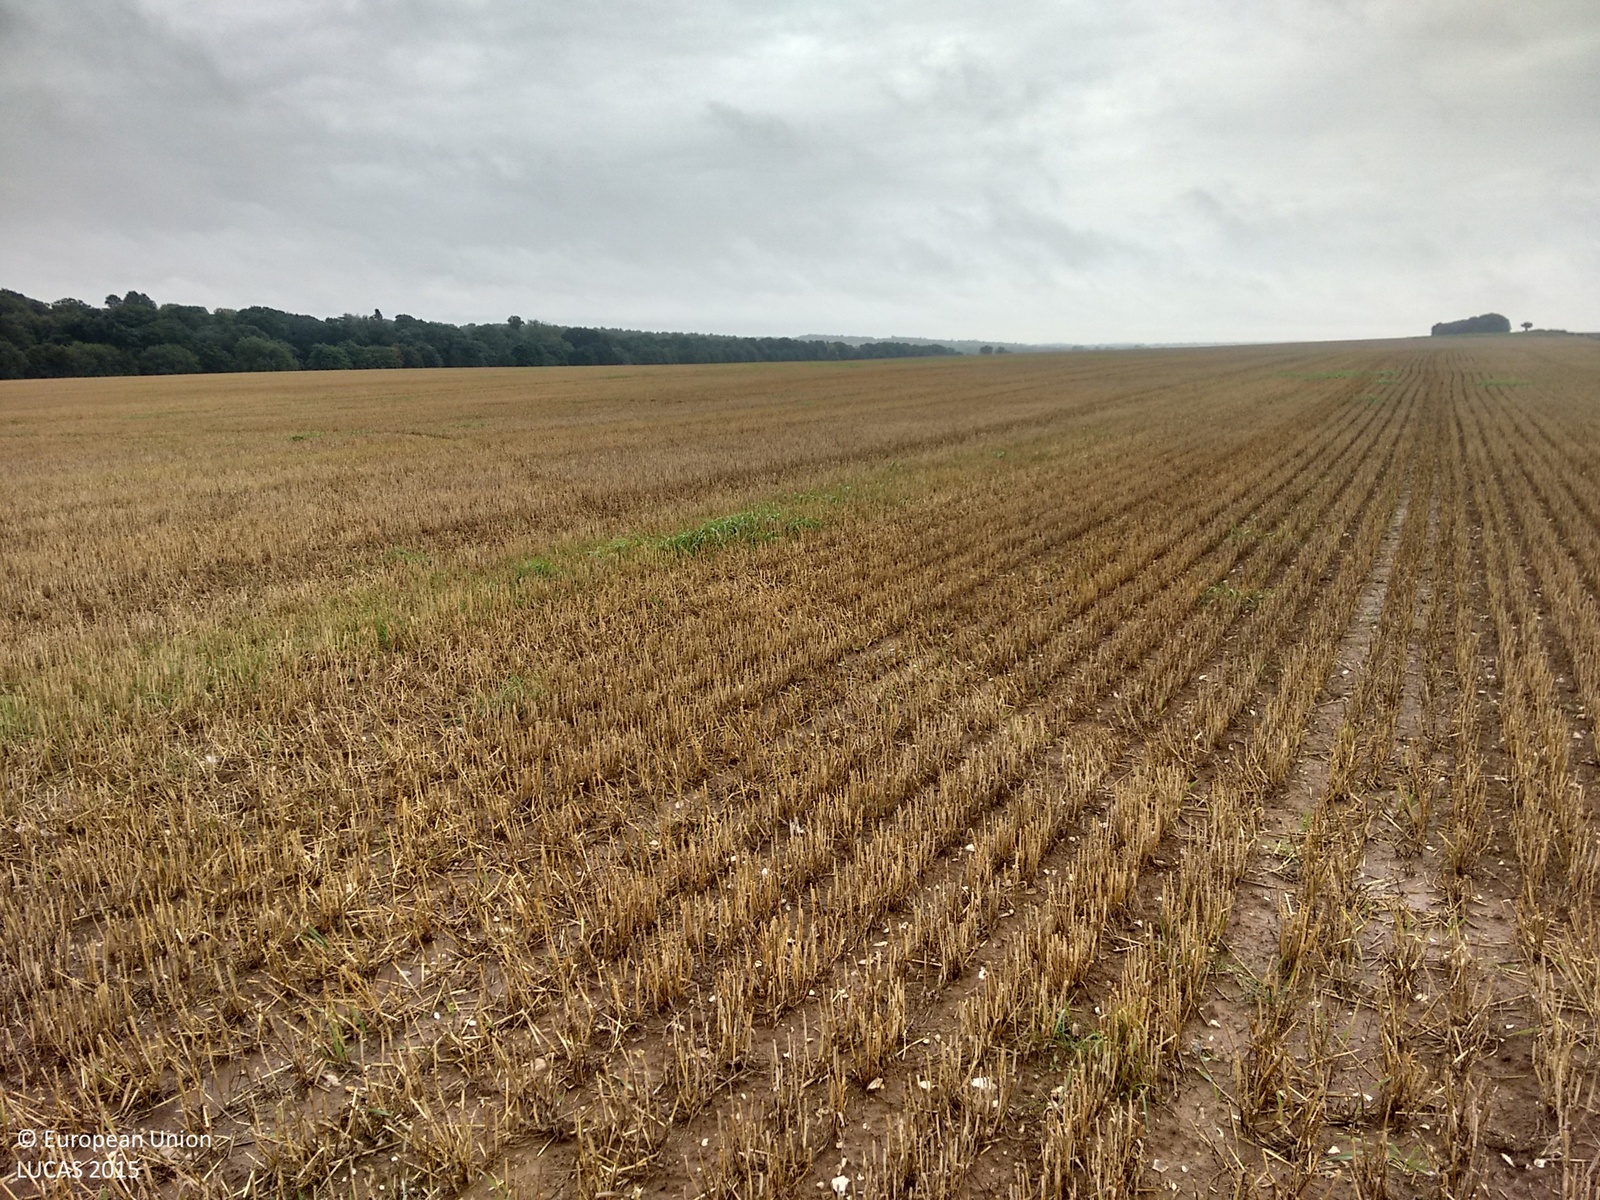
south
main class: Cropland
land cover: Barley
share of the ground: 50 - 75 %
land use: Agriculture (excluding fallow land and kitchen gardens)
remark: Harvested field
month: August
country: GB
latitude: 52.1077
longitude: 0.3193
